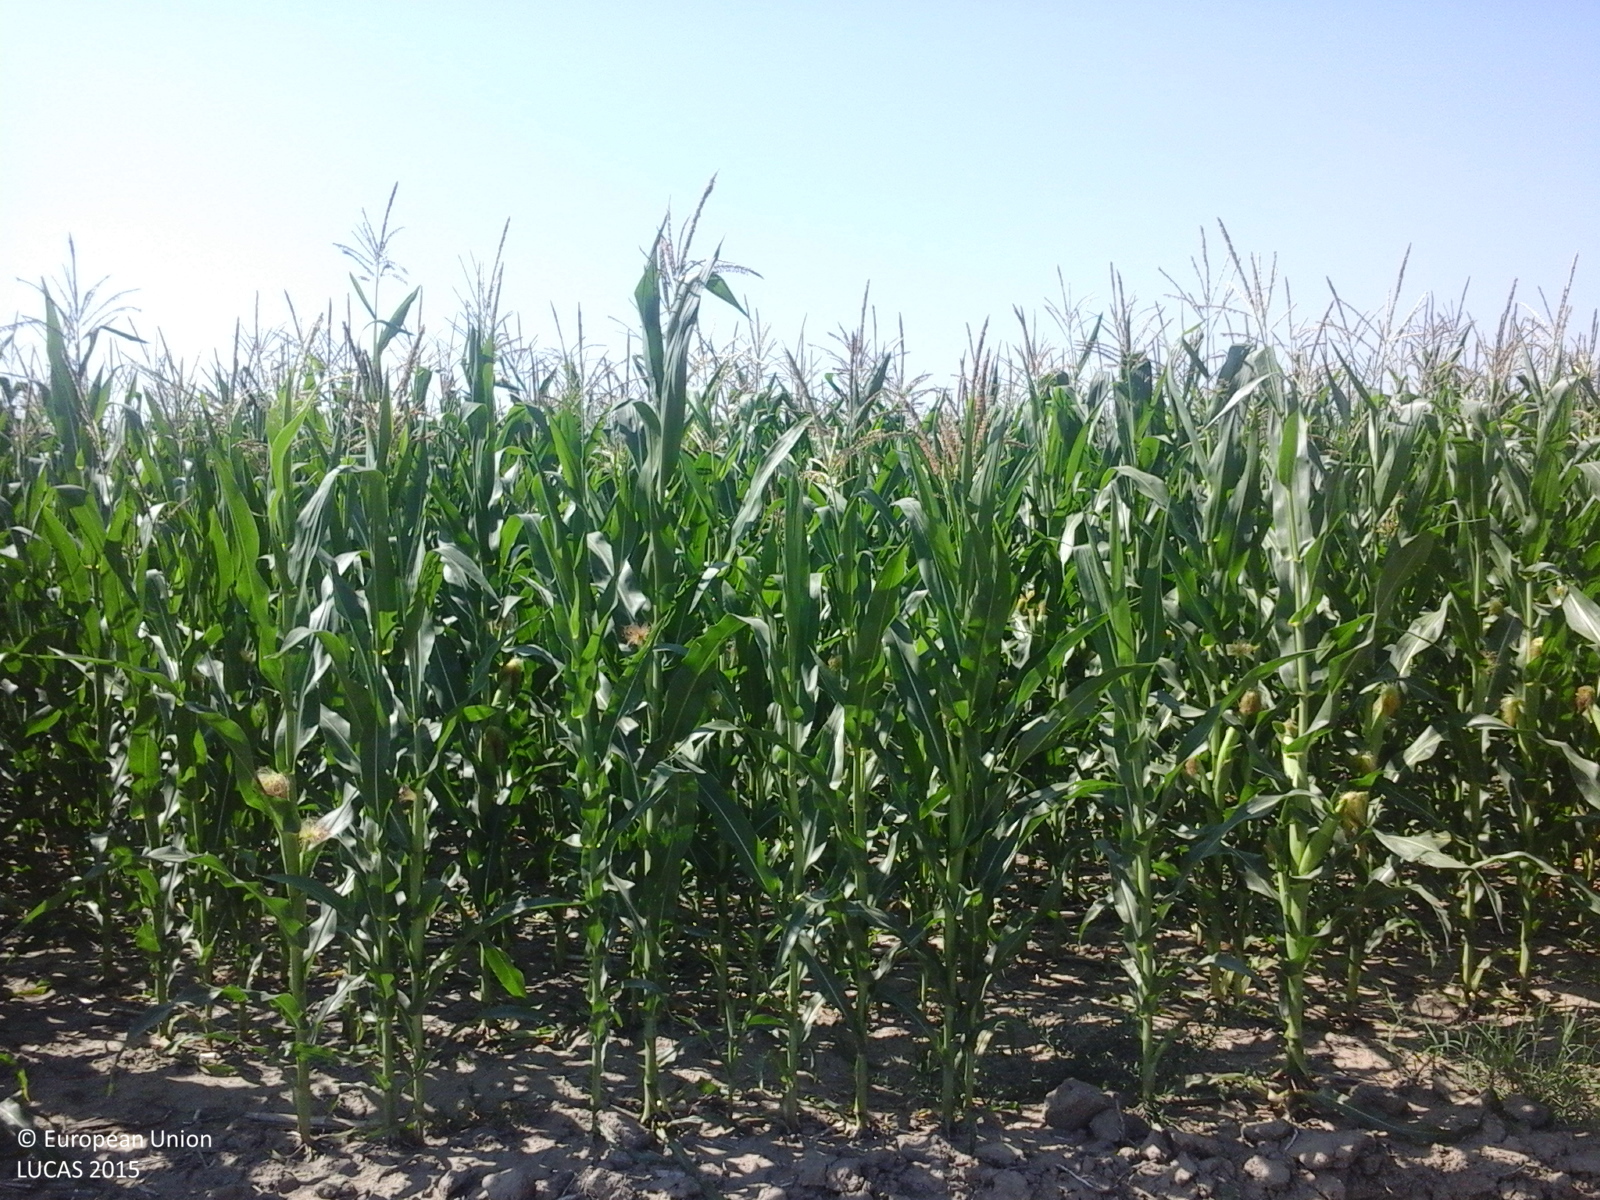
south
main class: Cropland
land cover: Maize
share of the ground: > 75 %
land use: Agriculture (excluding fallow land and kitchen gardens)
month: July
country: RO
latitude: 44.1606
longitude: 27.0451
